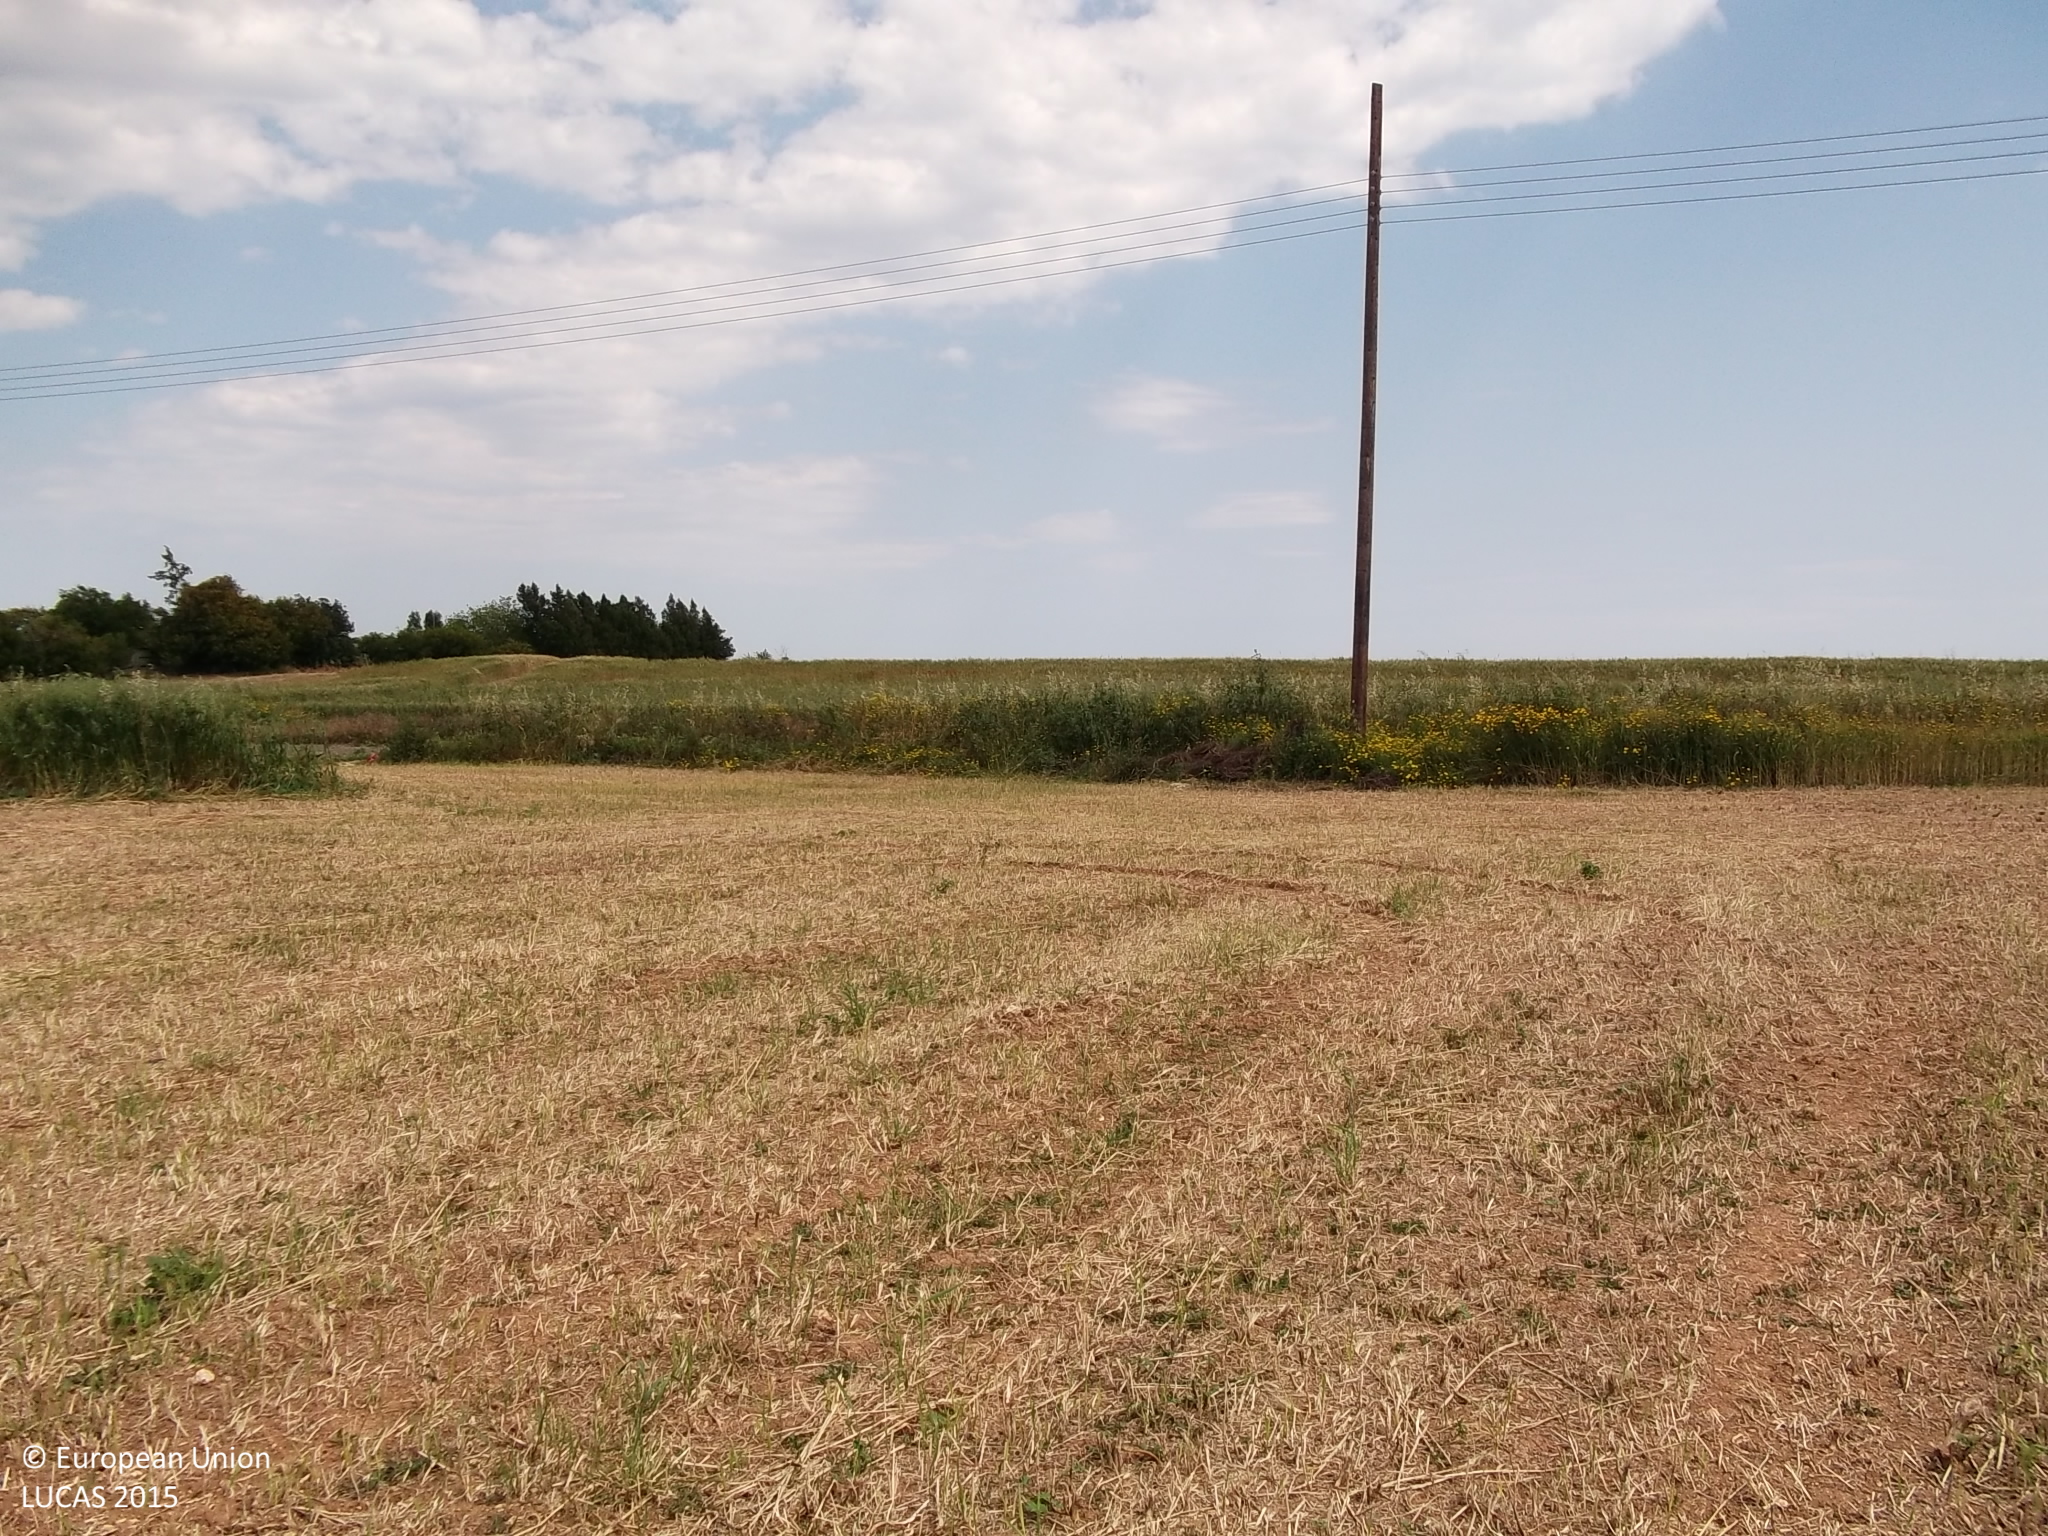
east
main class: Cropland
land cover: Common wheat
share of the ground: < 10 %
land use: Agriculture (excluding fallow land and kitchen gardens)
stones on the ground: < 10 %
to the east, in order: Common wheat; Electric lines; Grass margins; Paved roads, cycling and walking lanes; Mixed cereals for fodder; Paved roads, cycling and walking lanes; Mixed cereals for fodder; Other coniferous woodland; Artificial constructions in urban areas; Olive groves; Barley
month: April
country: CY
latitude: 34.8251
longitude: 33.5324
